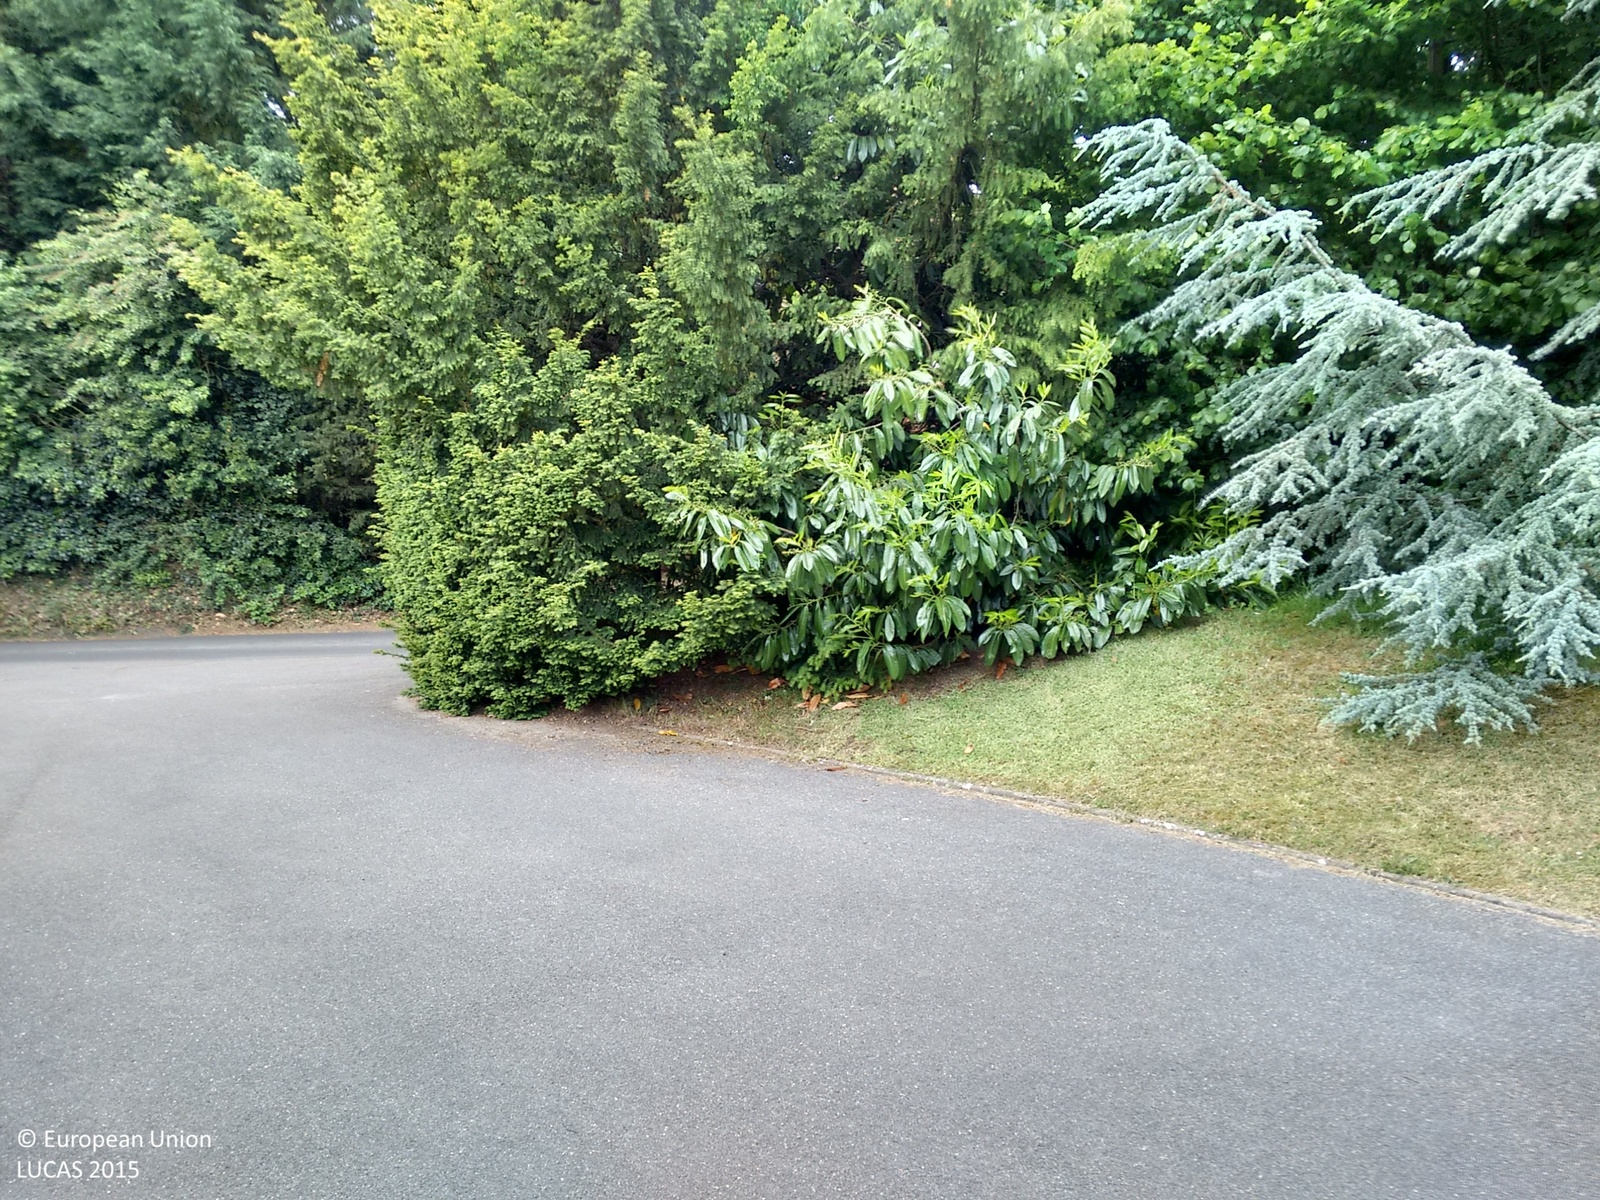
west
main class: Grassland
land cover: Grassland without tree/shrub cover
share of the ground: > 75 %
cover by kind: herbaceous plants 100 %
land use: Residential
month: June
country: GB
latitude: 51.5630
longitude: -0.7304
